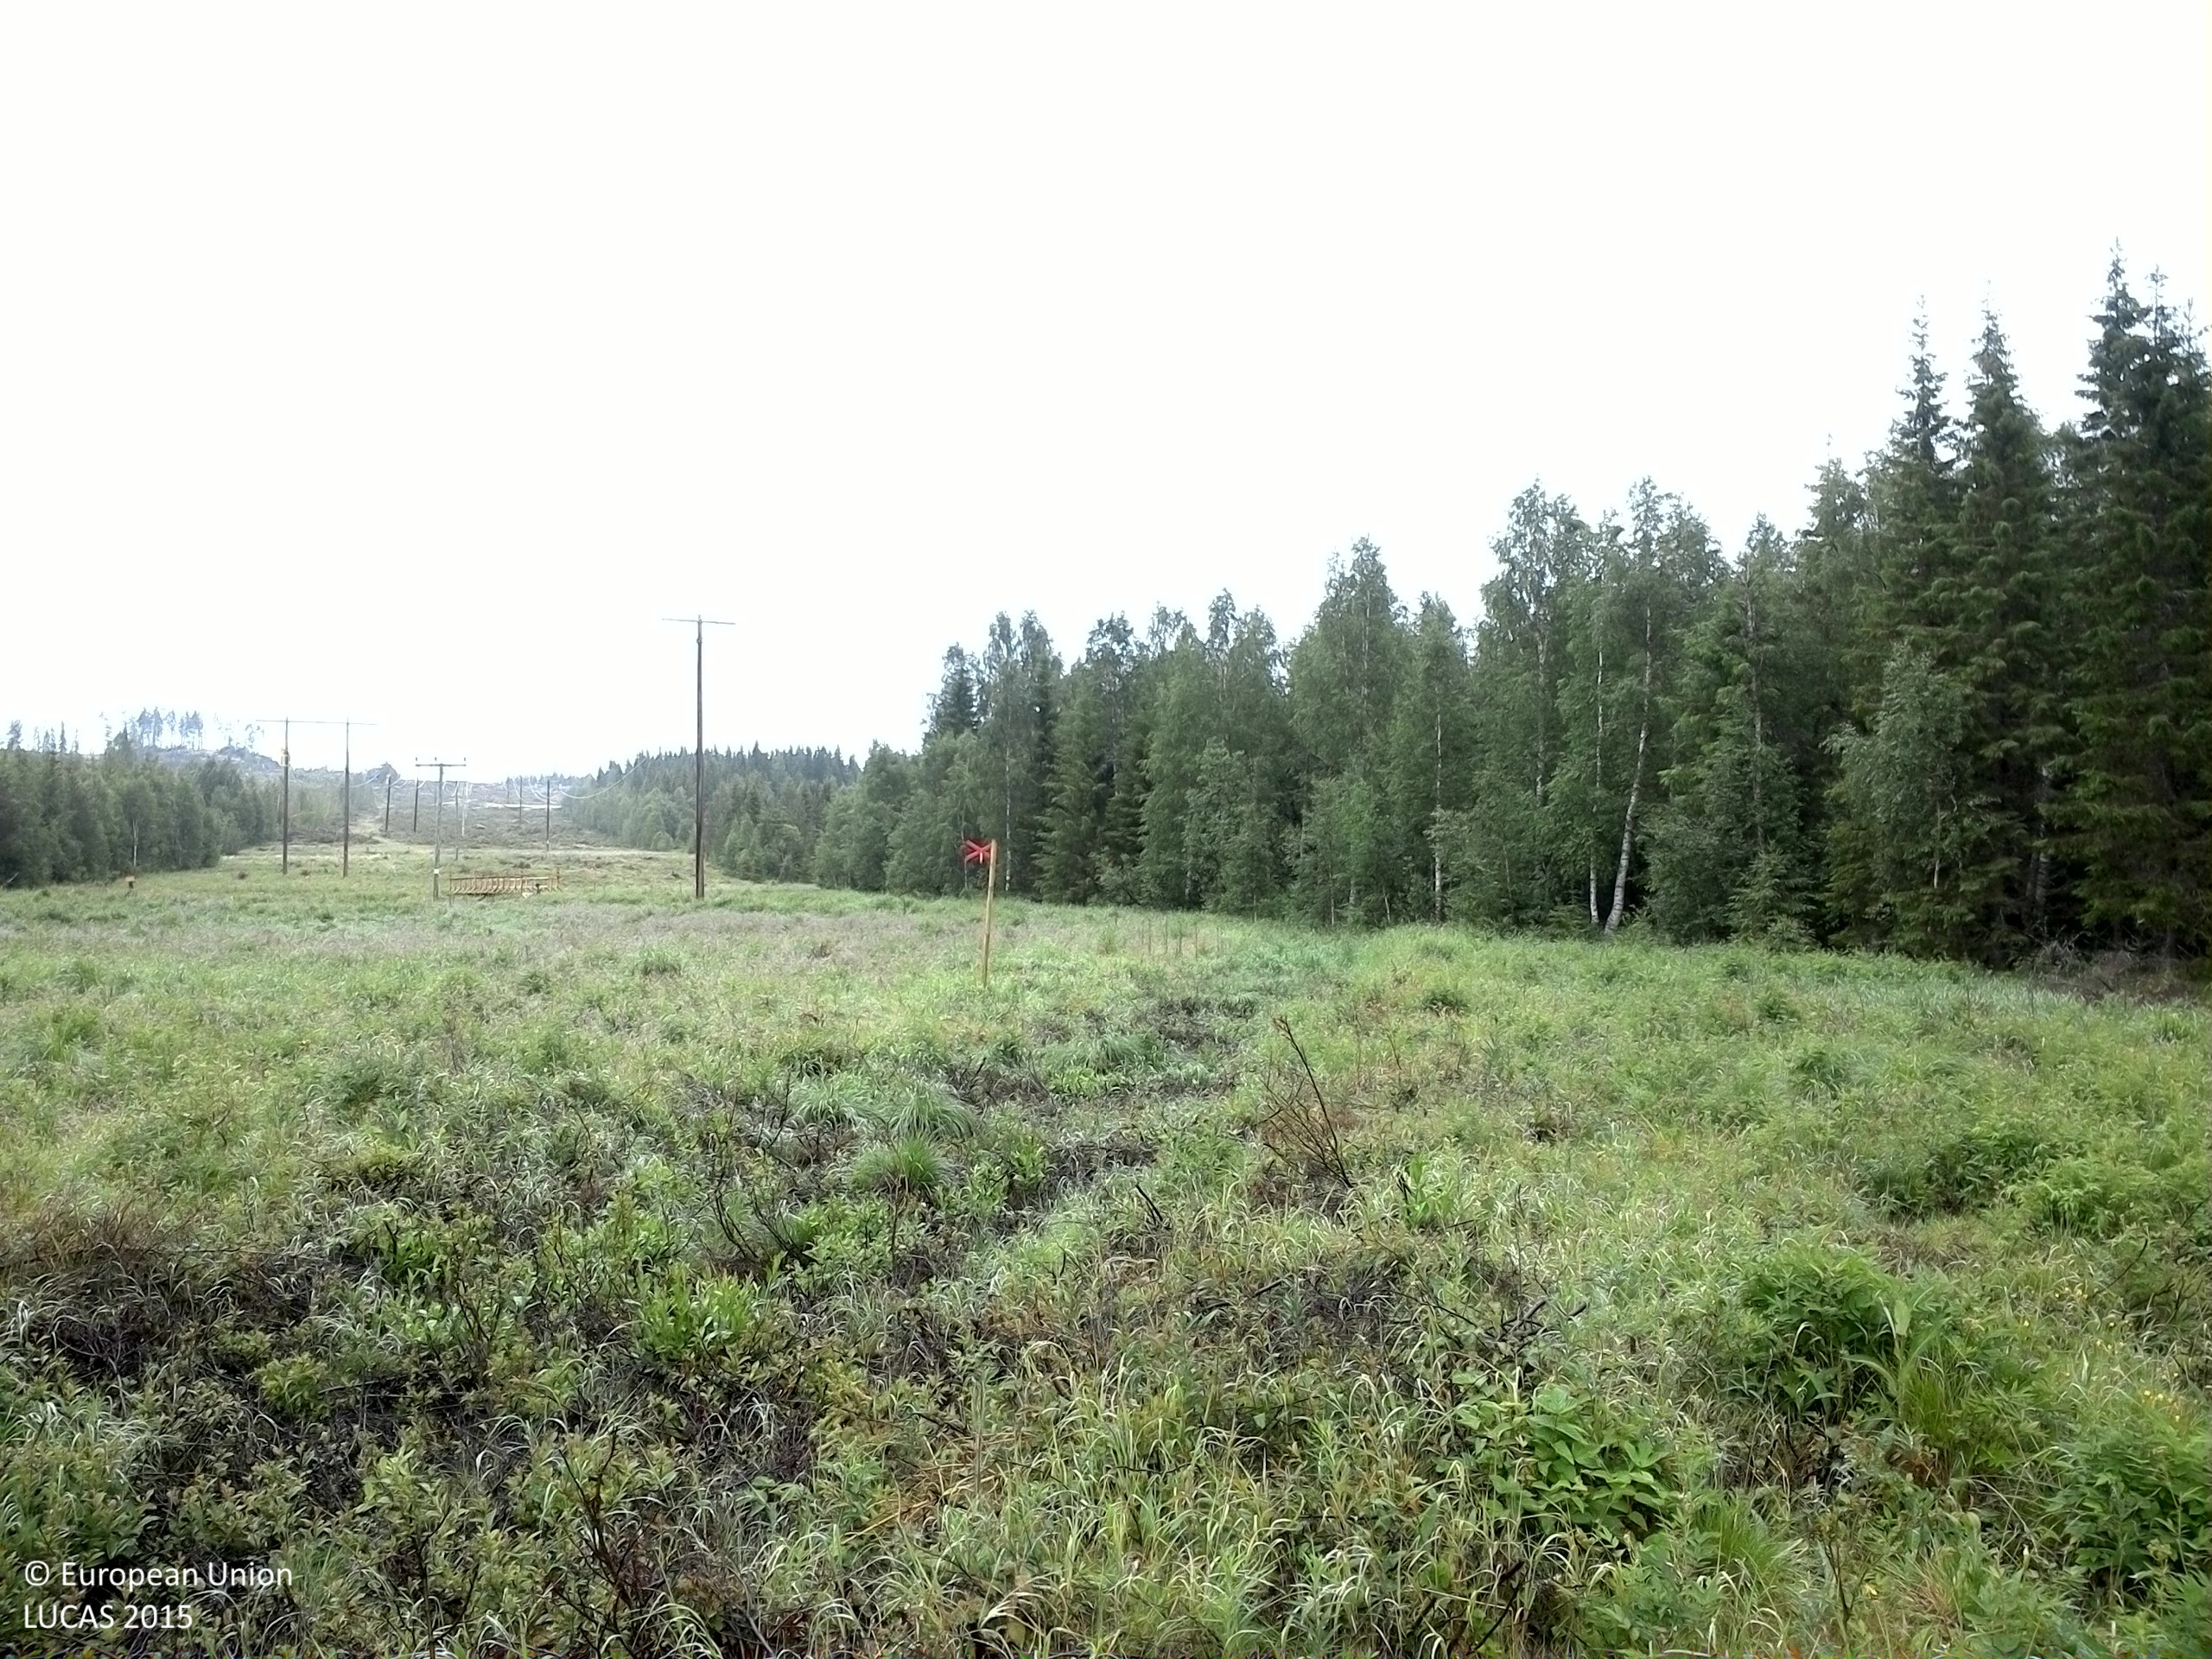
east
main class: Artificial land
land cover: Other artificial areas
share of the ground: 10 - 25 %
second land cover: Shrubland without tree cover
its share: > 75 %
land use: Electricity, gas and thermal power distribution
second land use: Amenities, museums, leisure
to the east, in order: Artificial constructions in urban areas; Shrubland without tree cover; Broadleaved woodland; Spruce dominated mixed woodland
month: July
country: SE
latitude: 63.5485
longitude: 18.5679
